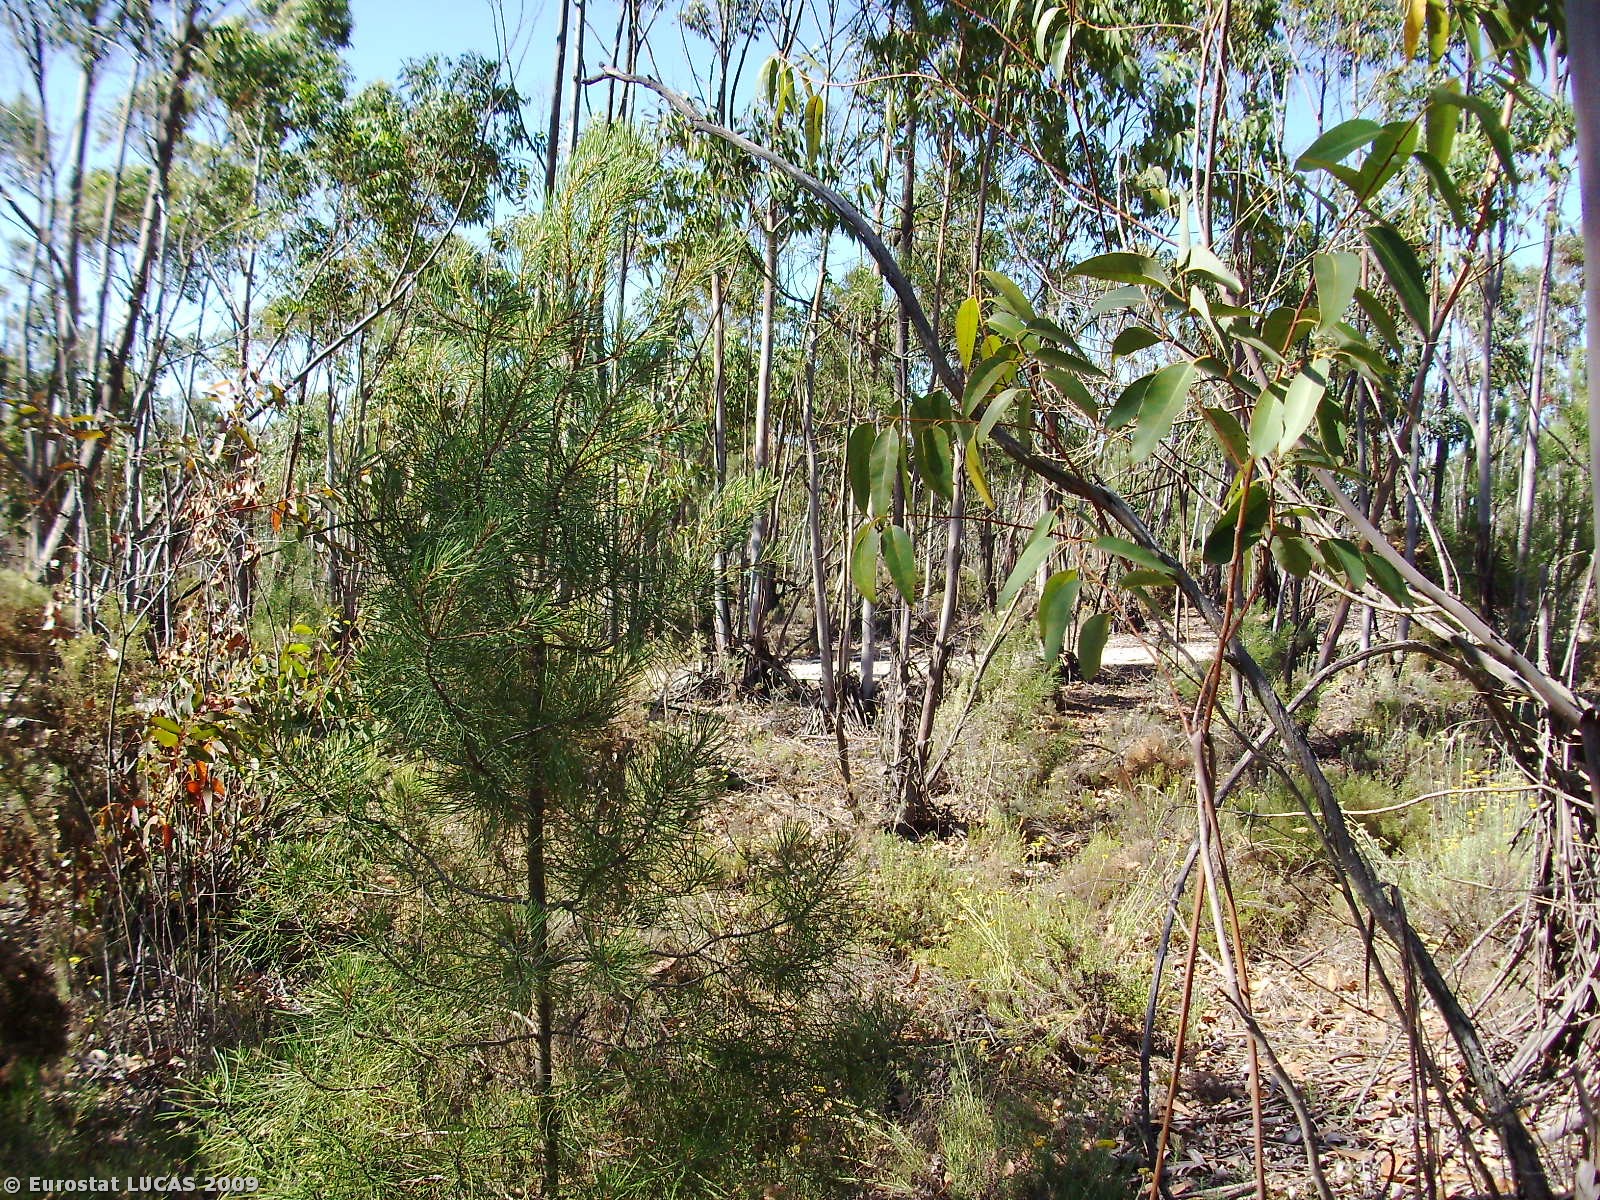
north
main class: Woodland
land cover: Broadleaved woodland
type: plantations and self-sown exotic forest
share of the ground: 50 - 75 %
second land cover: Shrubland with sparse tree cover
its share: 25 - 50 %
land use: Forestry
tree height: > 5 m
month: June
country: PT
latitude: 38.3108
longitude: -8.6607
